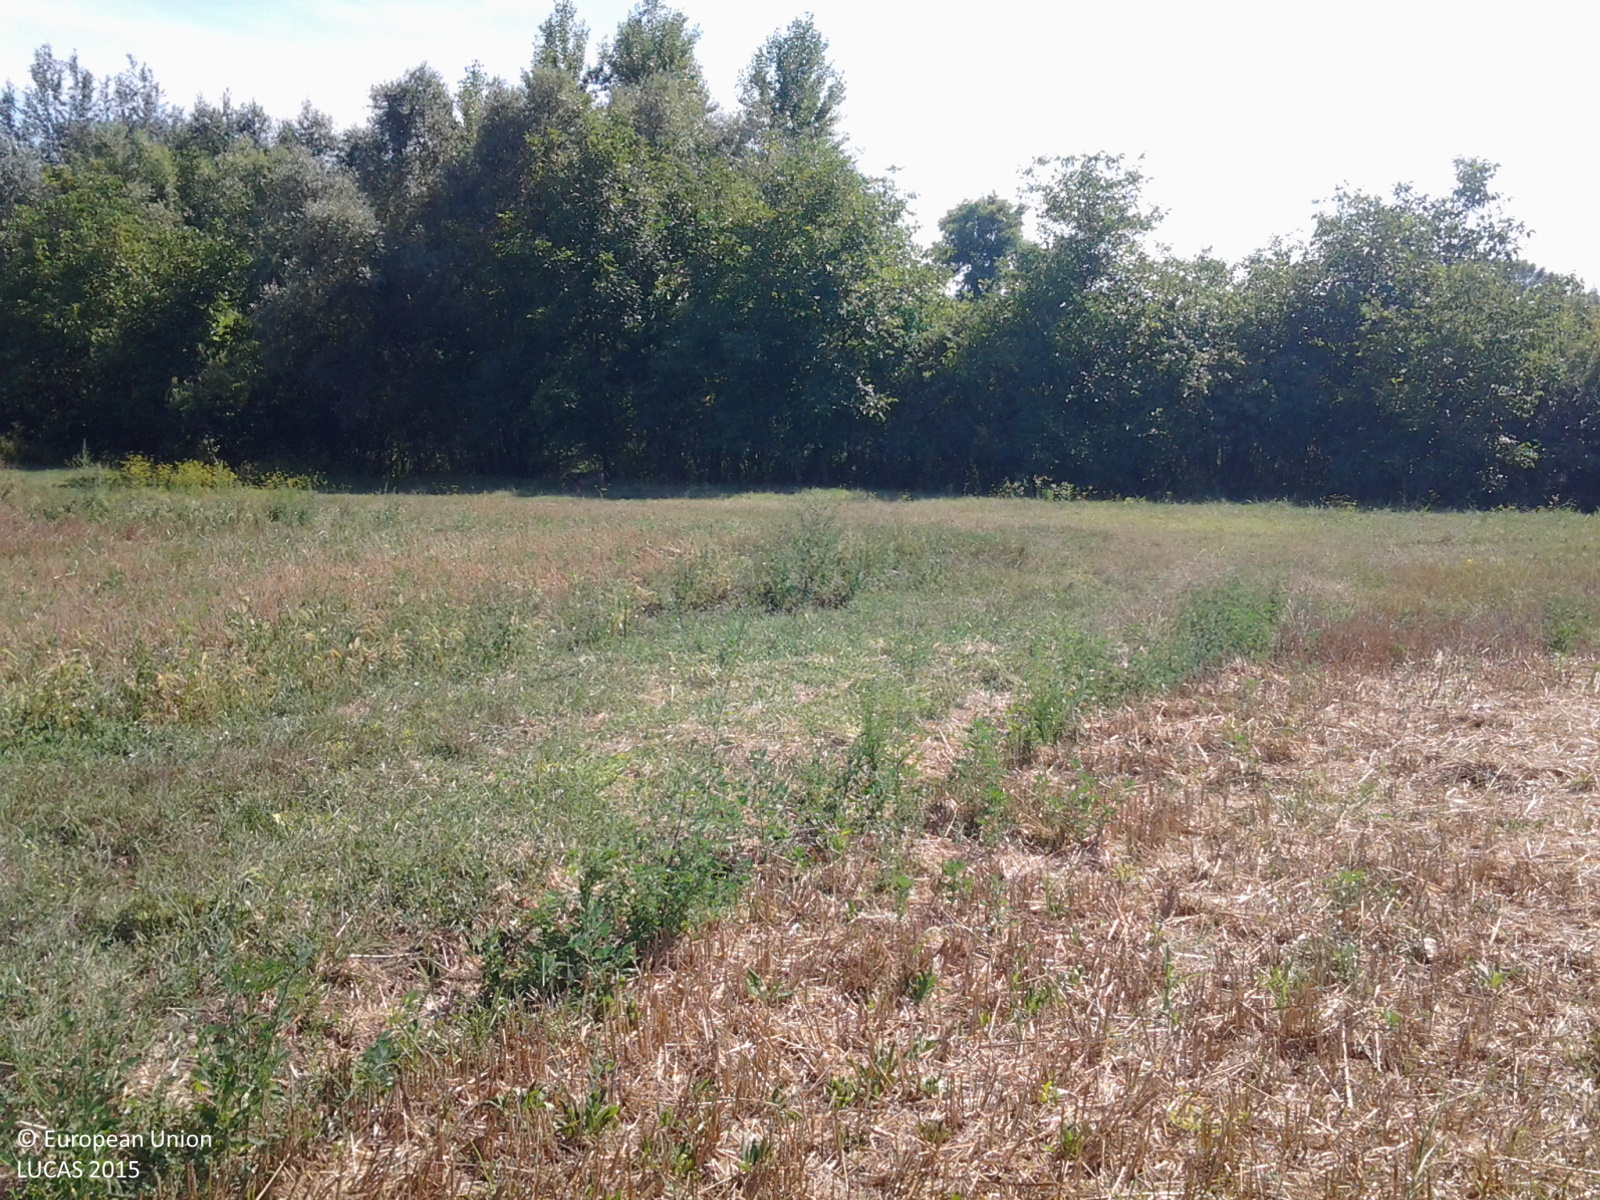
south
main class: Cropland
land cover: Triticale
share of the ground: > 75 %
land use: Agriculture (excluding fallow land and kitchen gardens)
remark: Harvested field
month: August
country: HU
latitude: 47.3681
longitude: 19.8096
